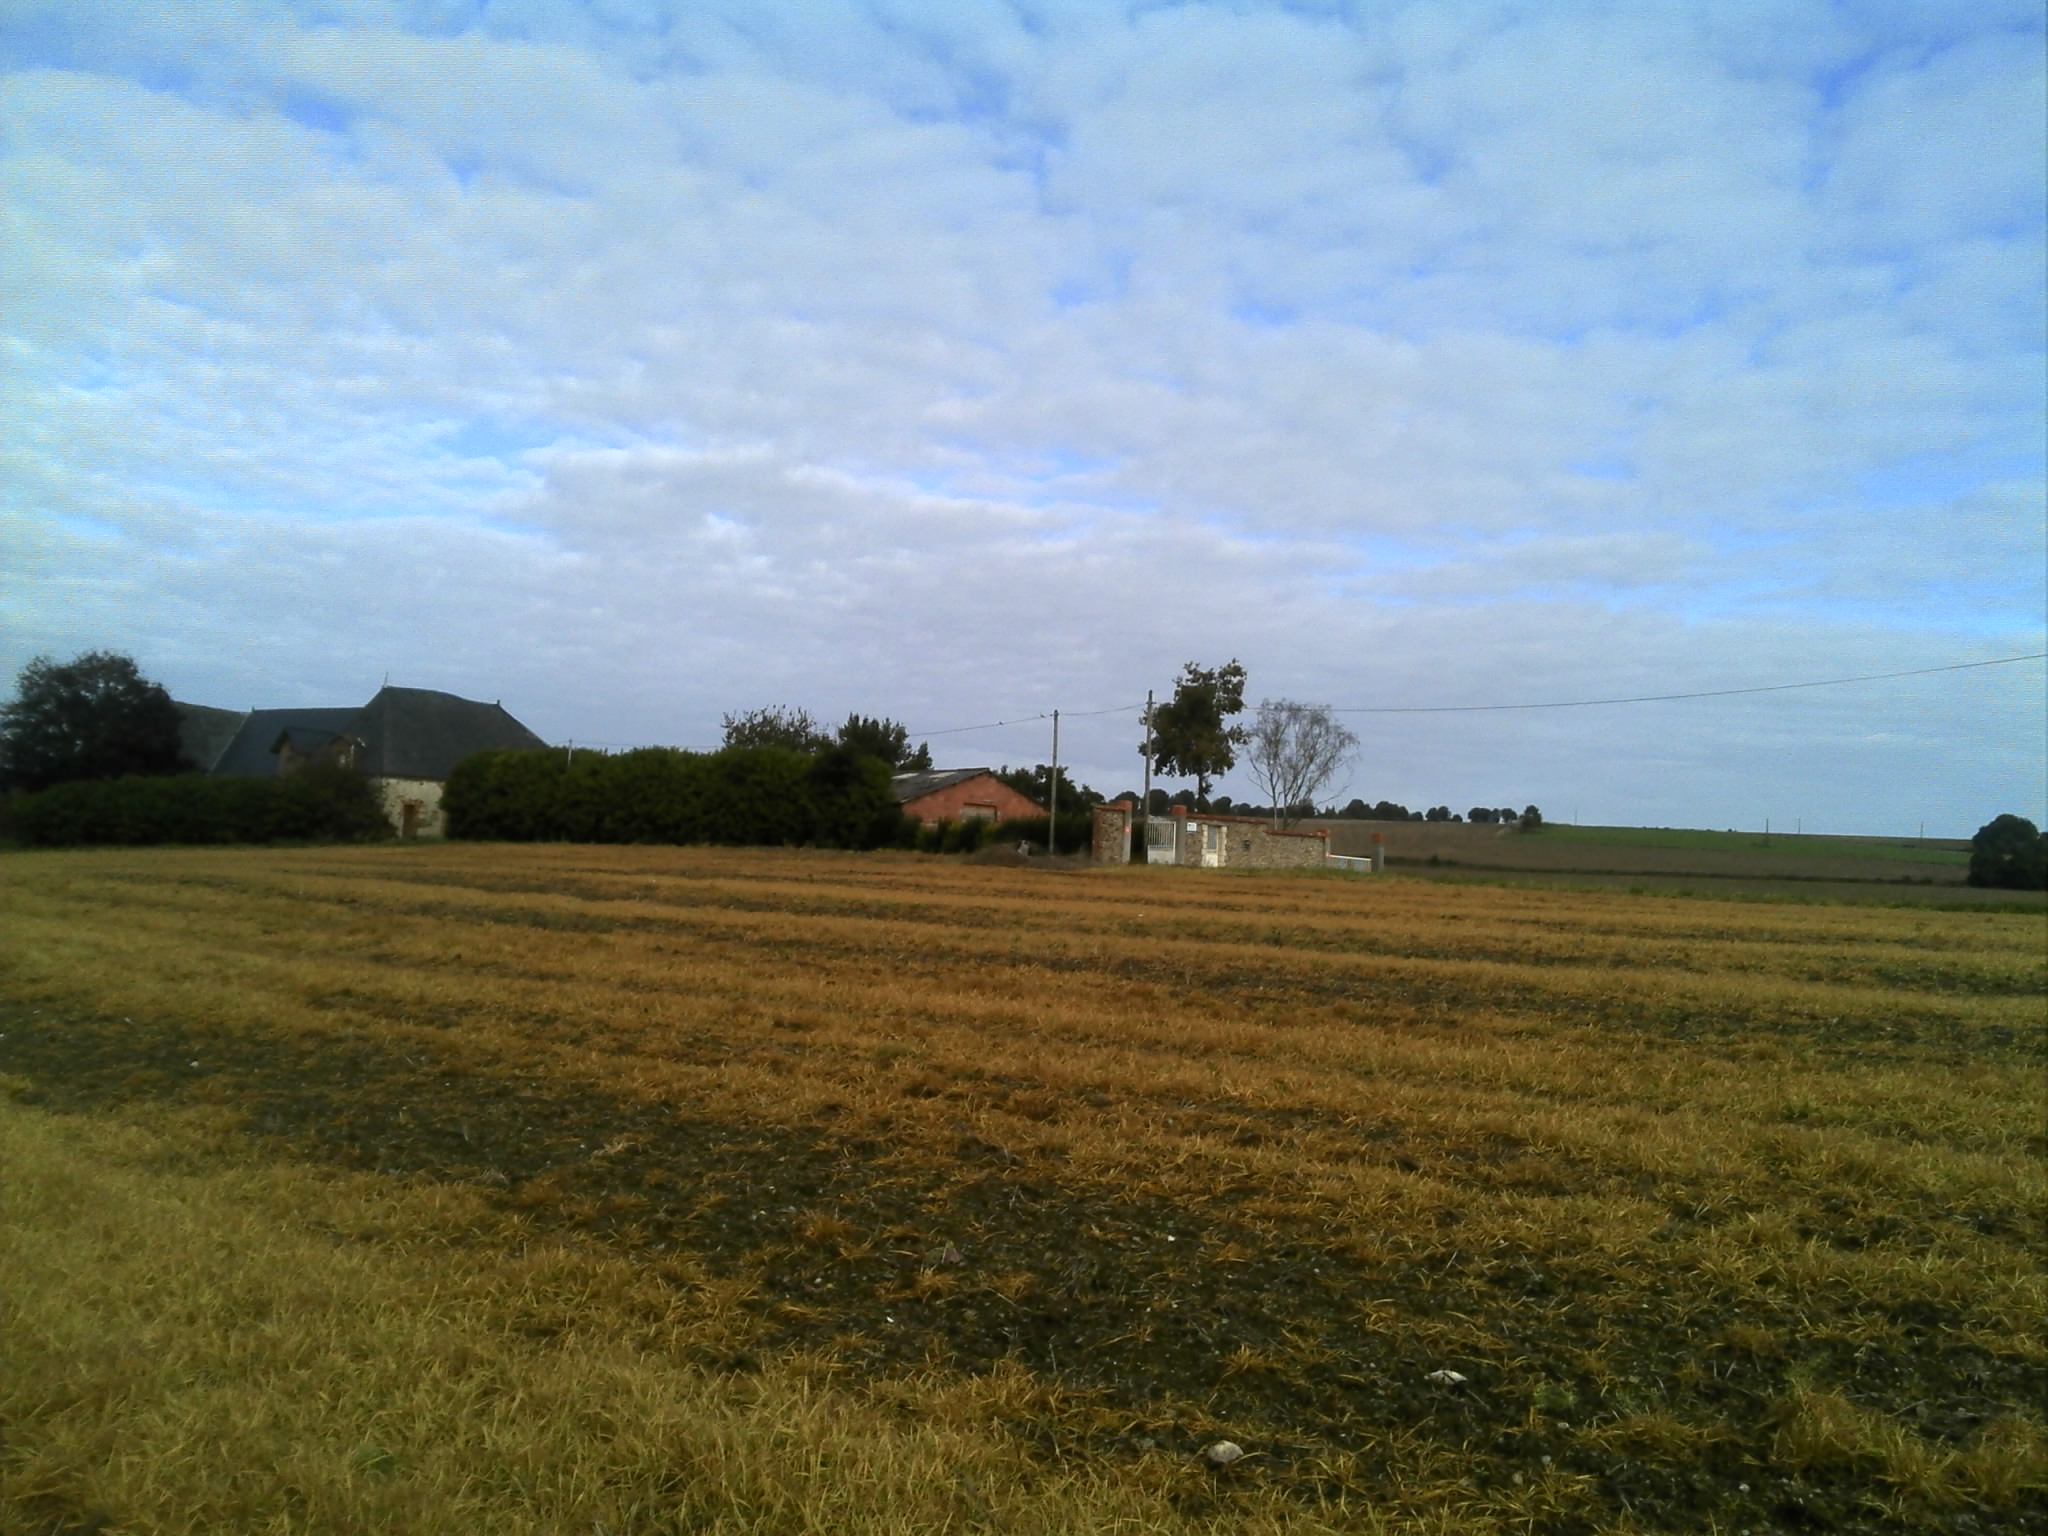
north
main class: Cropland
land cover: Common wheat
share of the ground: > 75 %
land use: Agriculture (excluding fallow land and kitchen gardens)
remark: Harvested field
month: October
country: FR
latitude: 47.7576
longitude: -1.0442
